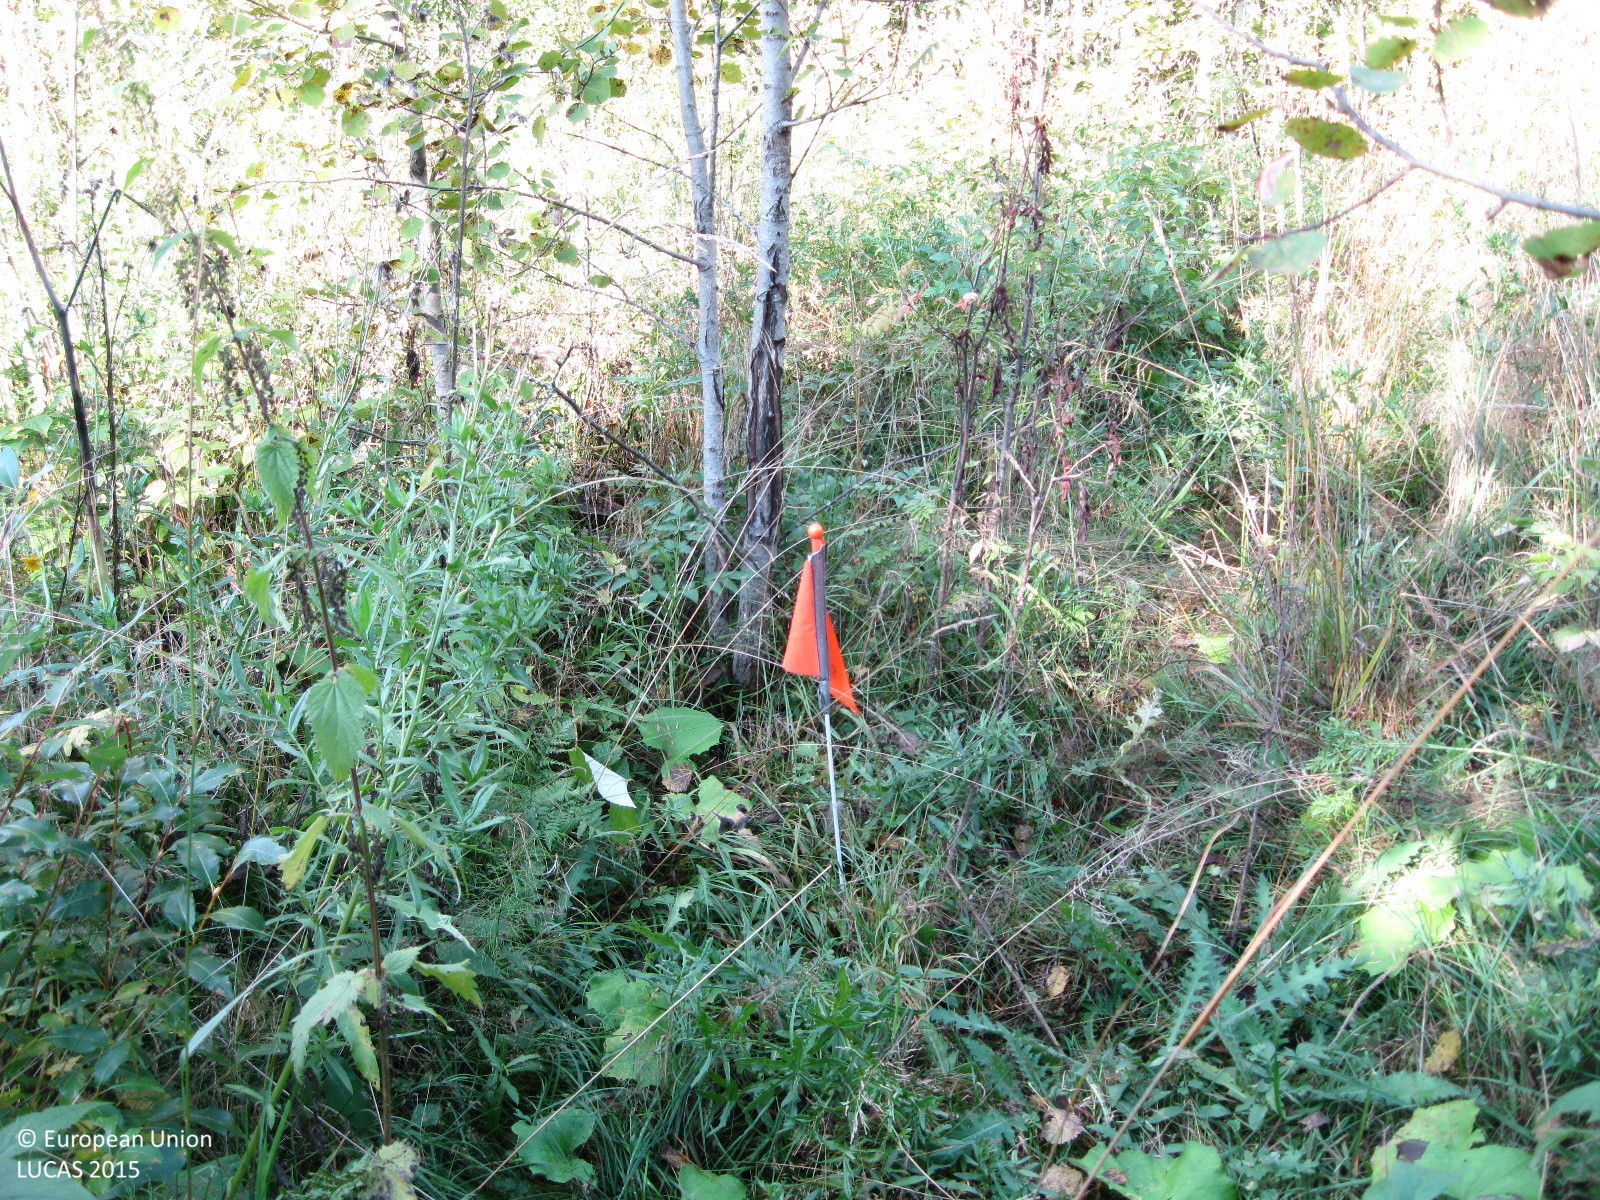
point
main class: Woodland
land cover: Broadleaved woodland
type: boreal forest
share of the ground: > 75 %
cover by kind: broadleaved forest trees 80 %, herbaceous plants 15 %, coniferous forest trees 5 %
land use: Forestry
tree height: > 5 m
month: September
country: FI
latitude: 60.5092
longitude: 24.8463
